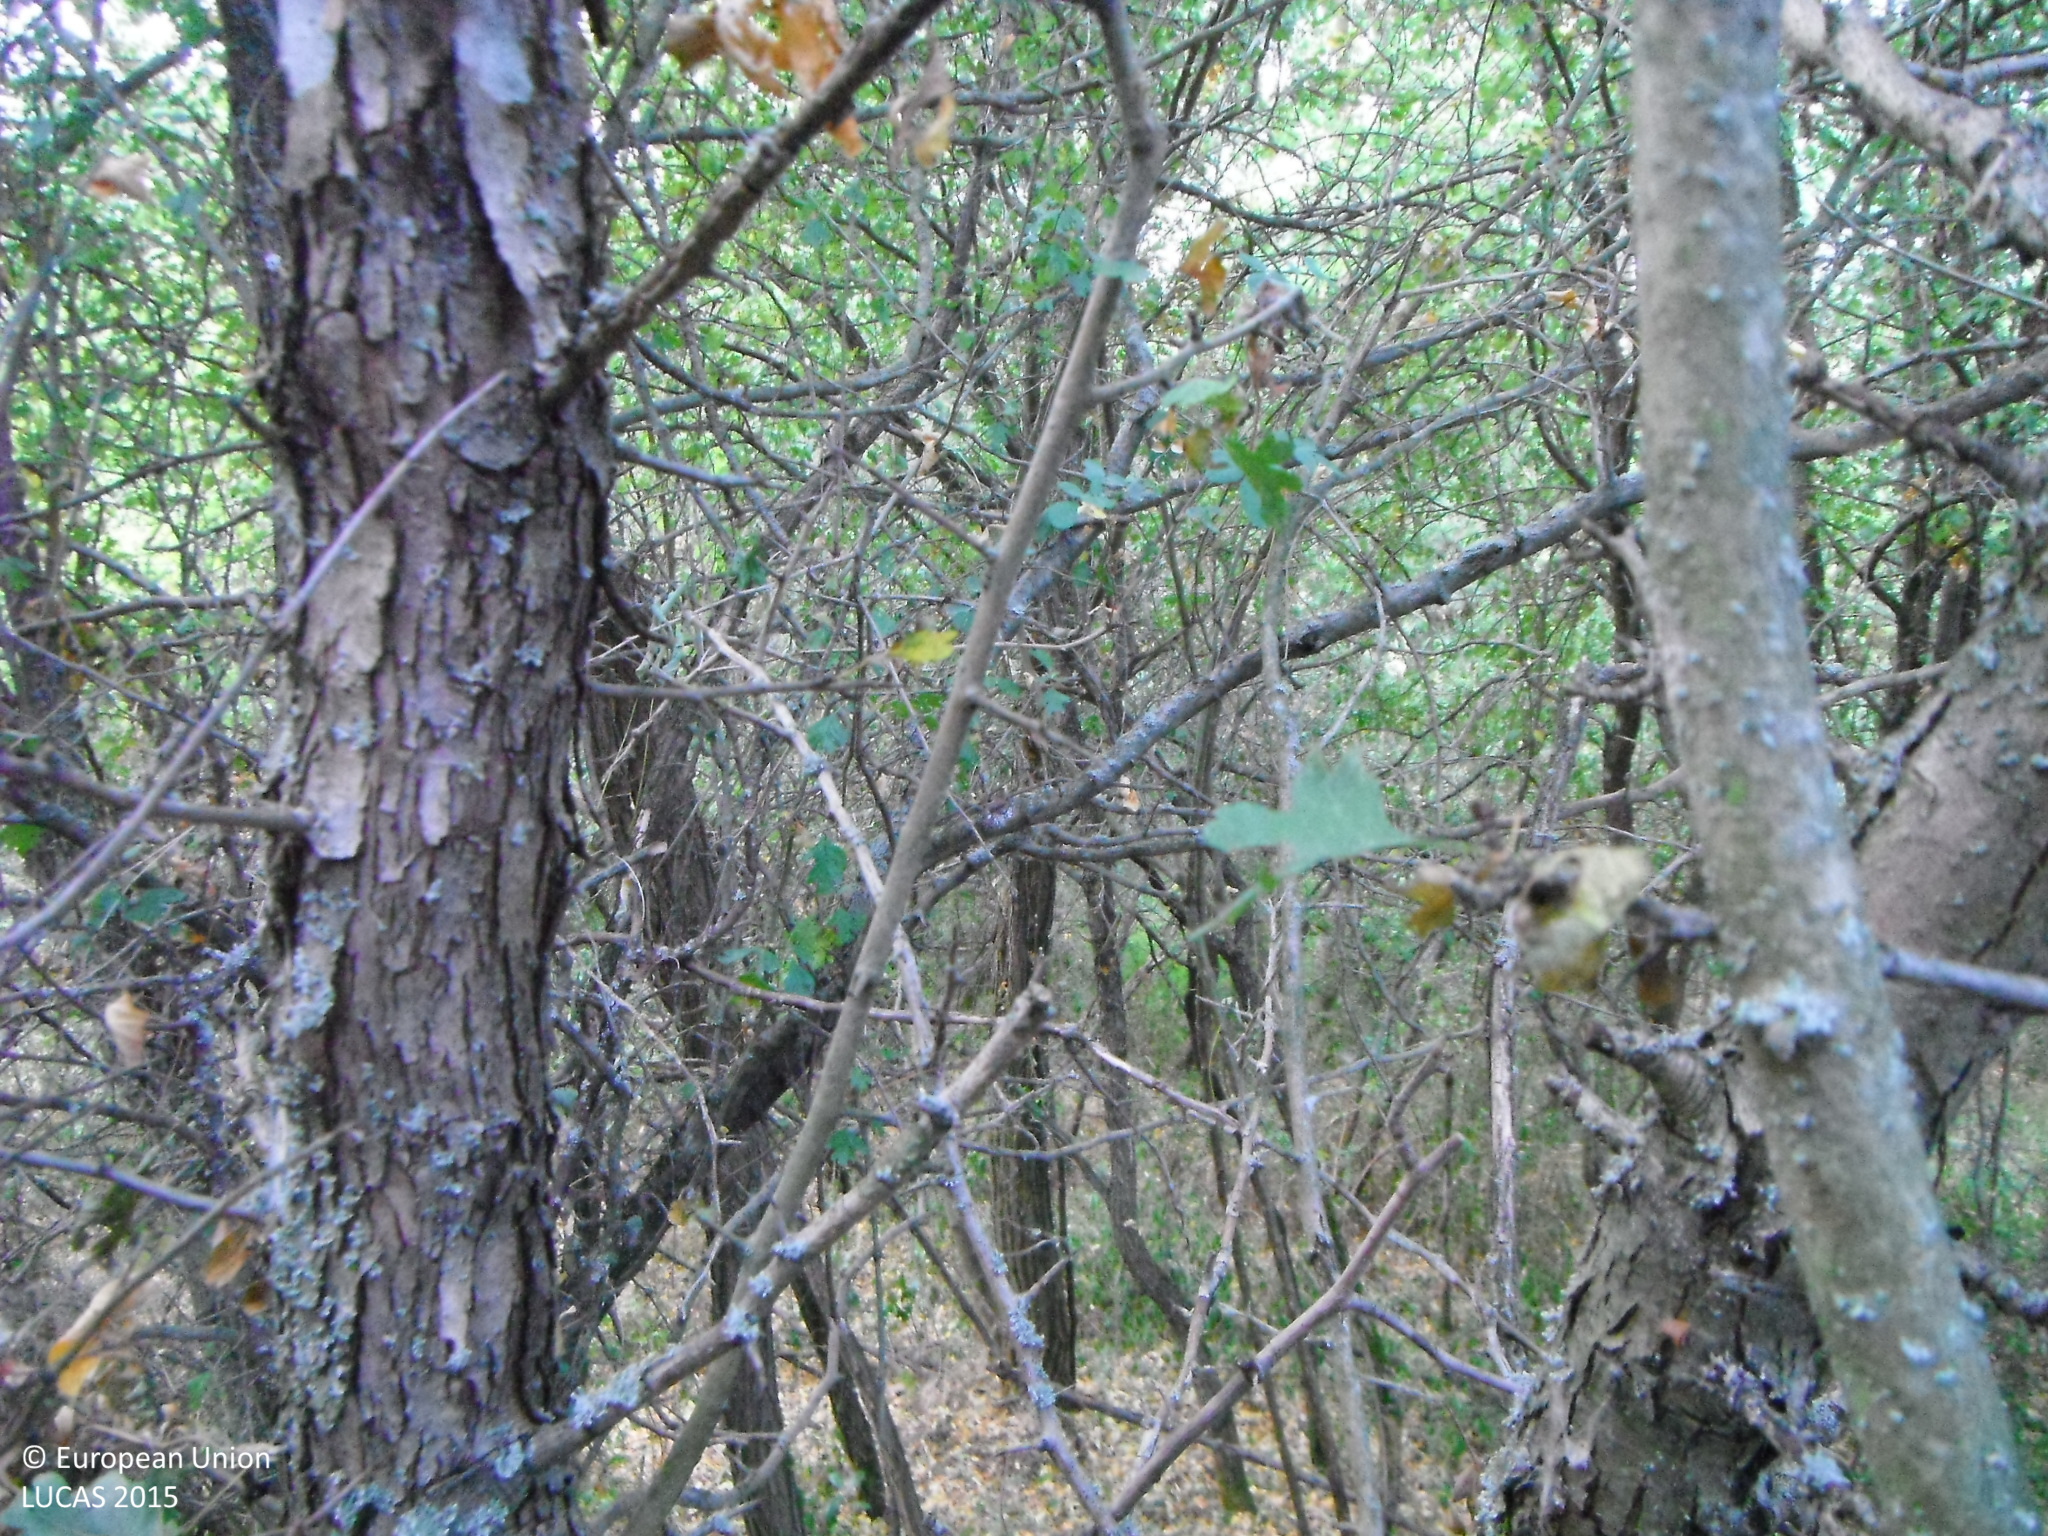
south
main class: Woodland
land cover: Broadleaved woodland
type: mesophytic deciduous forest
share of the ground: > 75 %
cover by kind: broadleaved forest trees 100 %
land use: Semi-natural and natural areas not in use
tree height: > 5 m
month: July
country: SK
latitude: 48.2640
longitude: 19.0869
